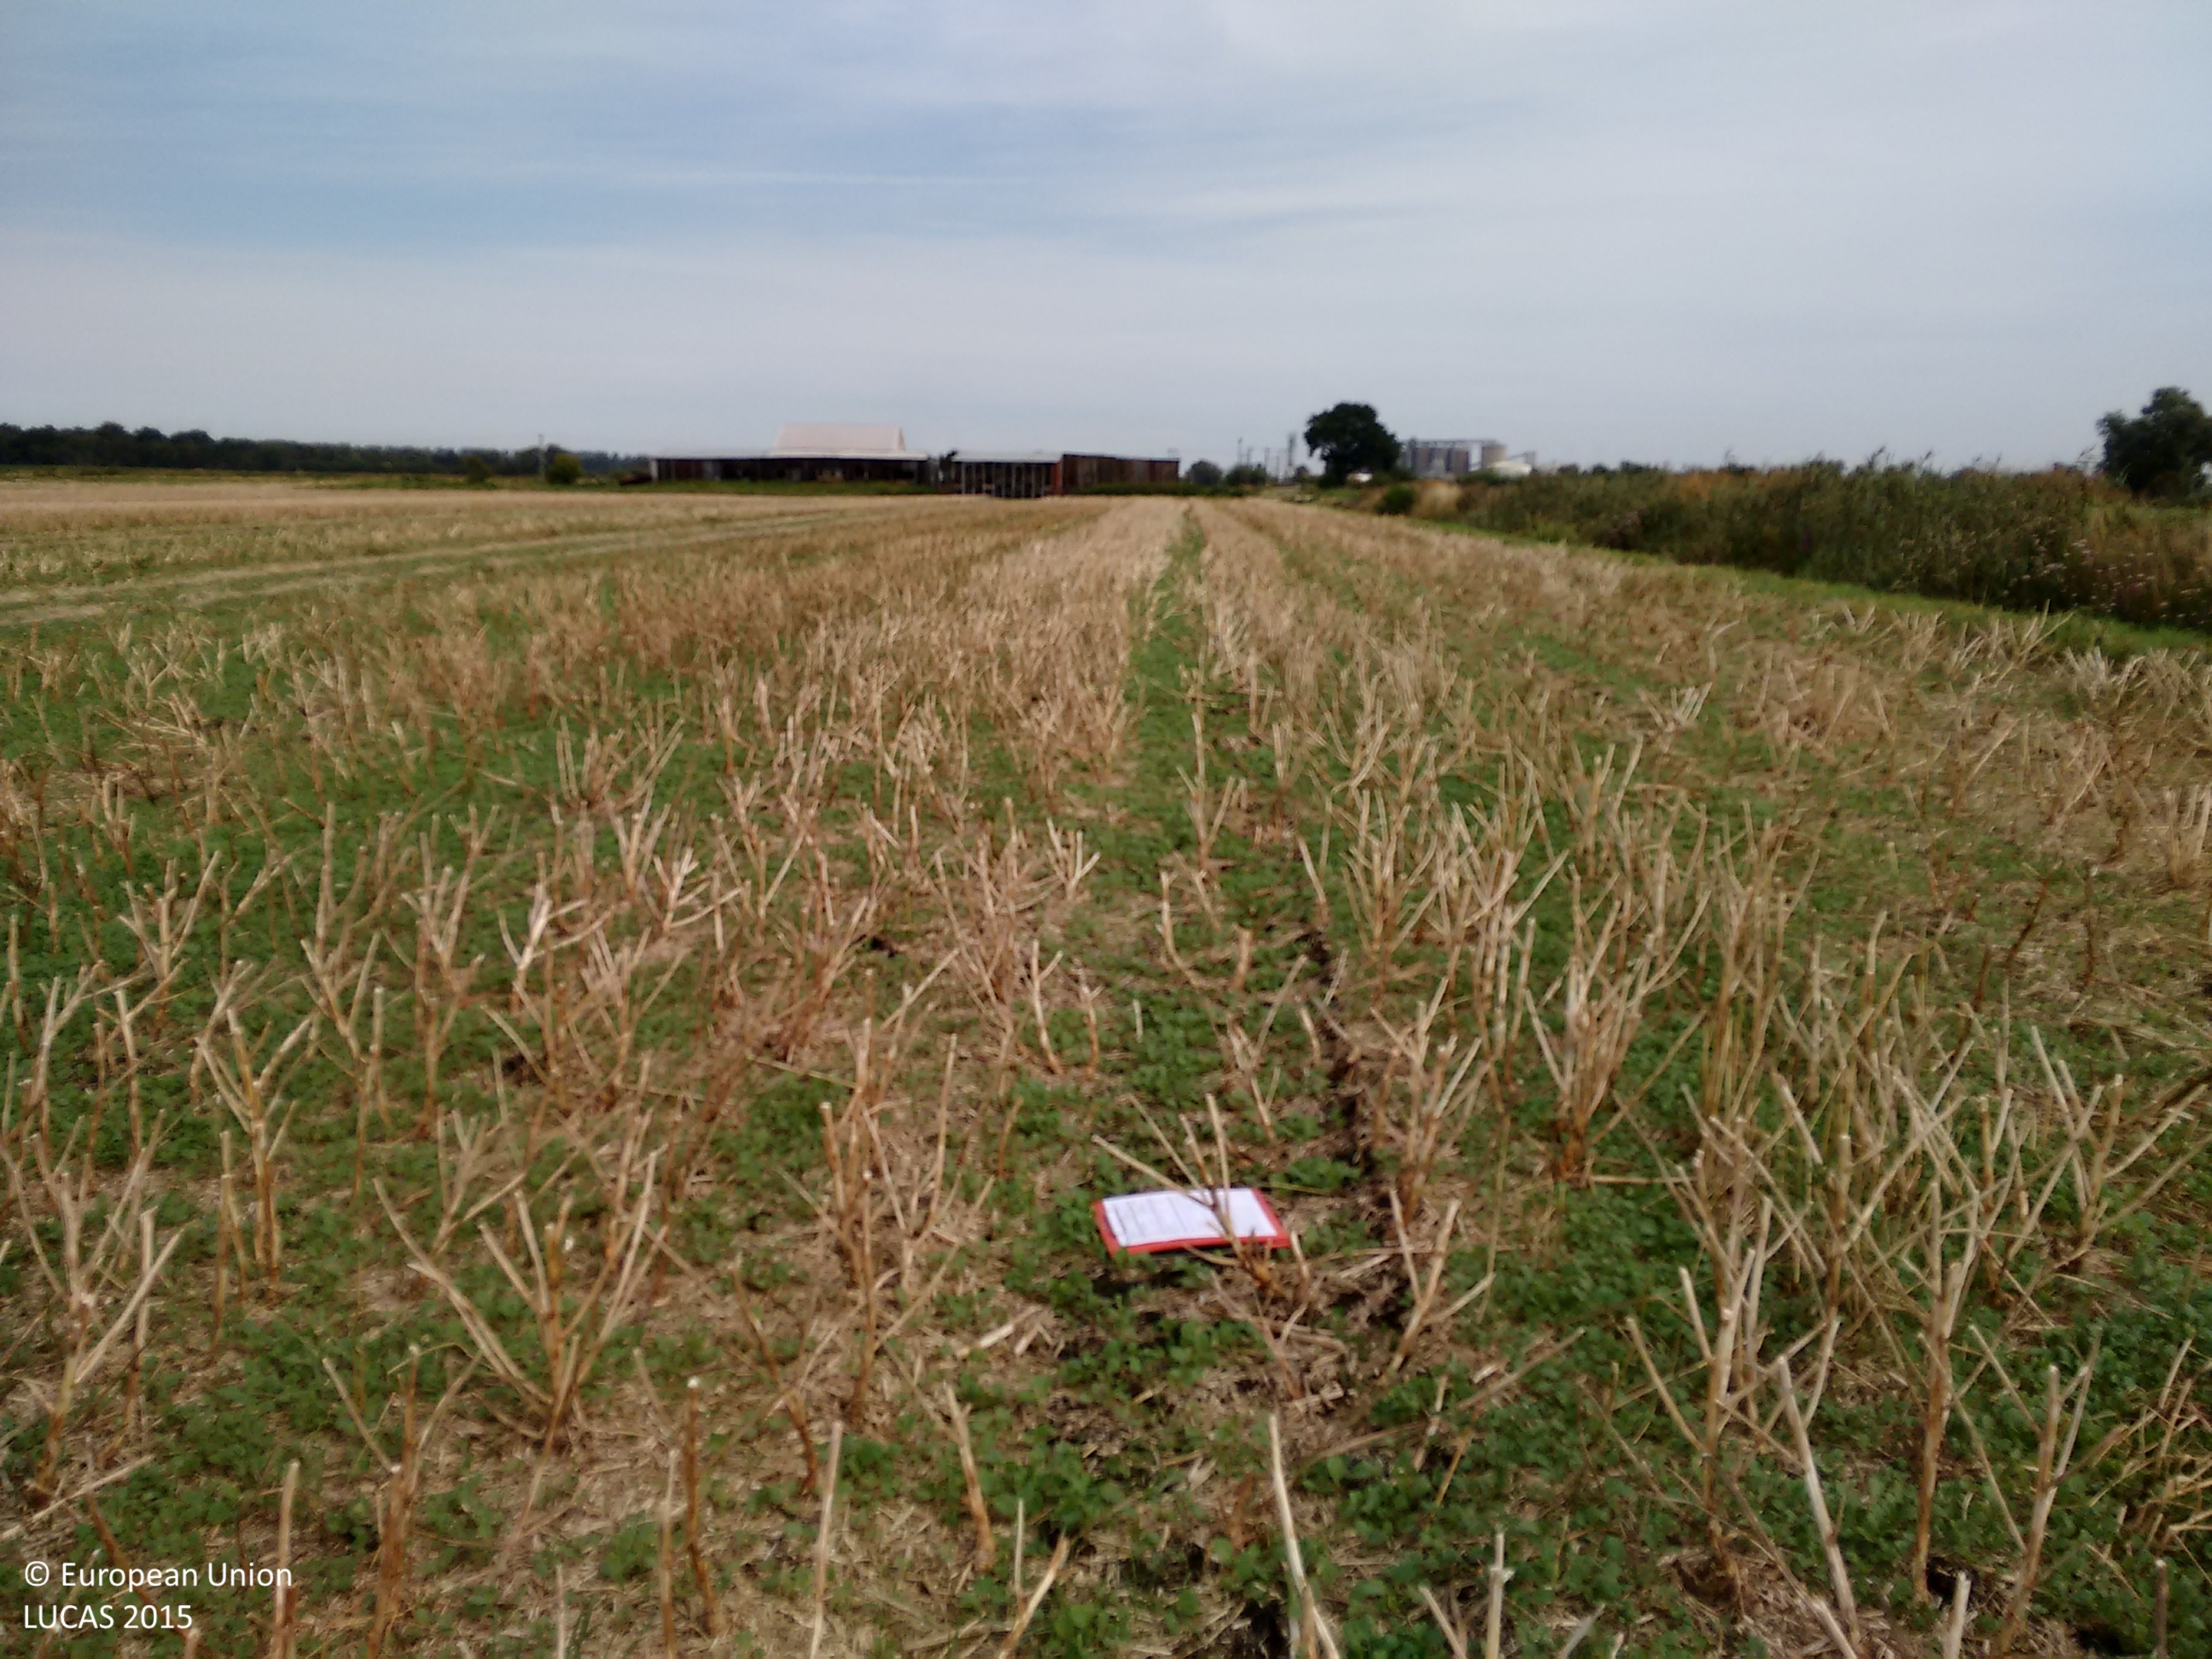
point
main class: Cropland
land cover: Rape and turnip rape
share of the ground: > 75 %
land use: Agriculture (excluding fallow land and kitchen gardens)
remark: Harvested field
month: August
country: GB
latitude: 52.5336
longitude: 0.4338
